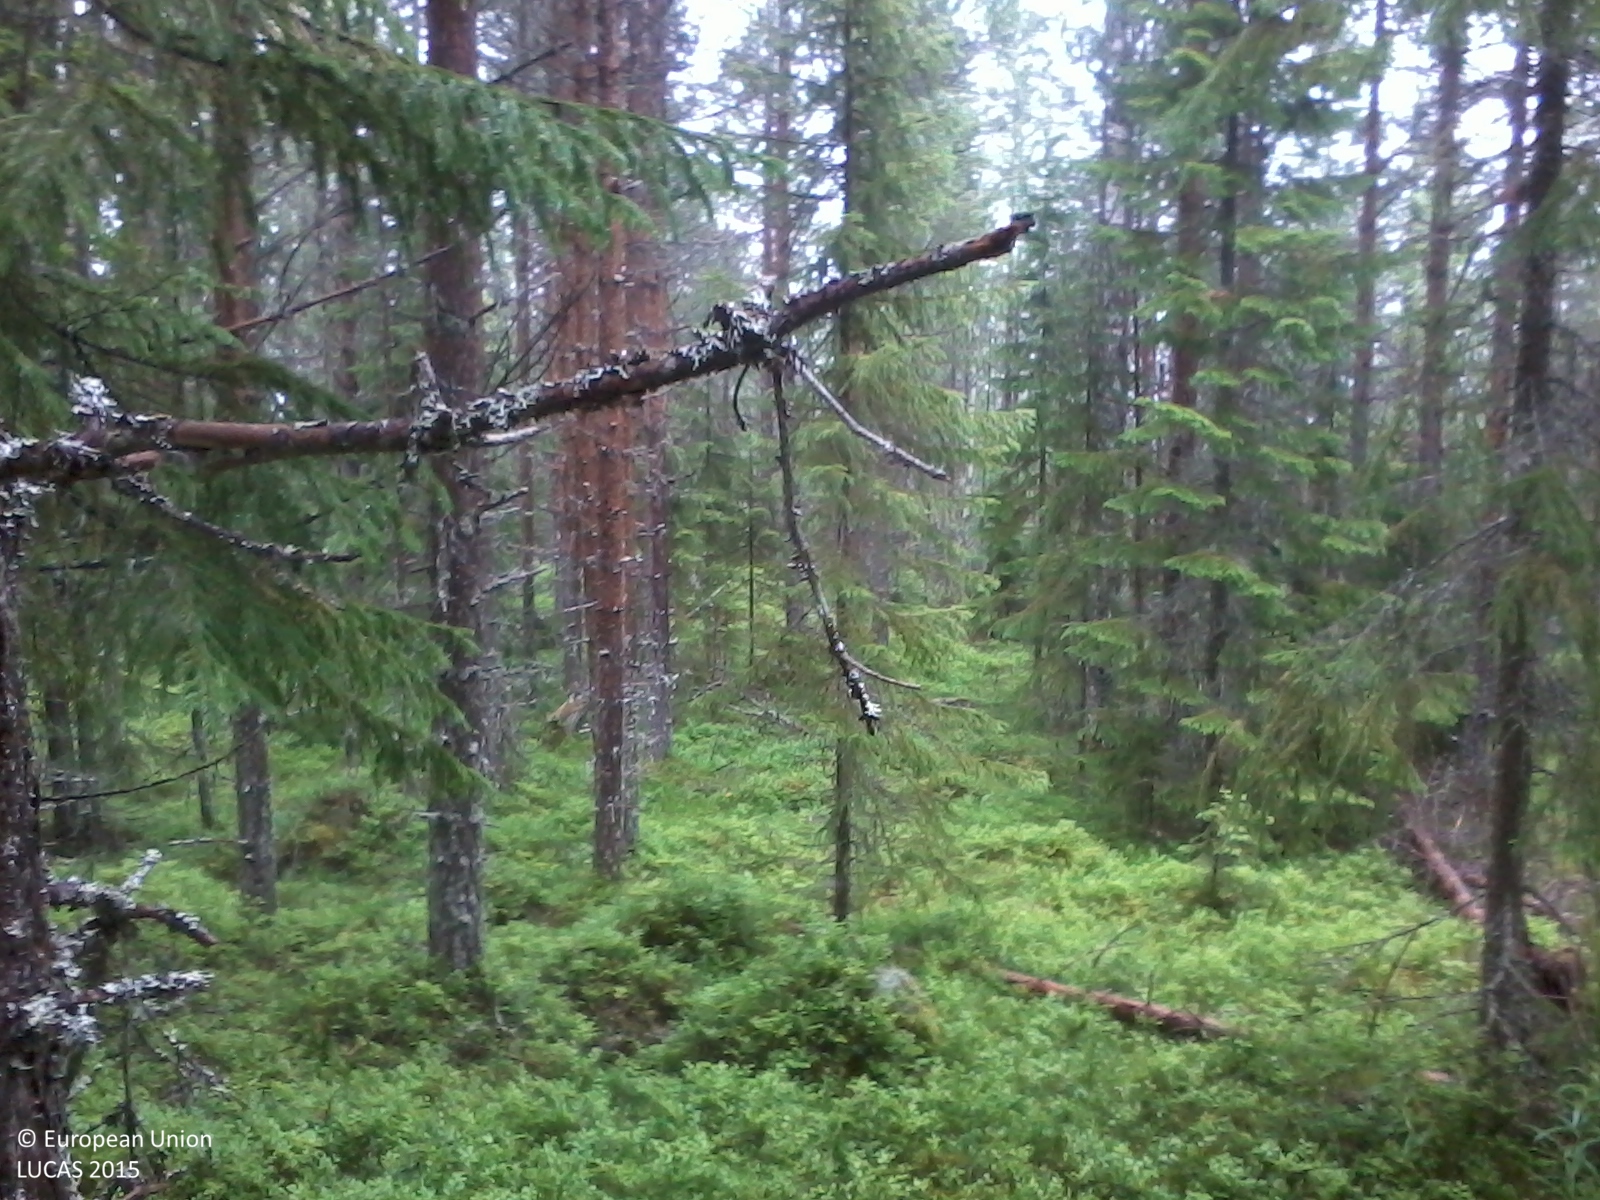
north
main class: Woodland
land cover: Pine dominated coniferous woodland
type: boreal forest
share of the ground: 50 - 75 %
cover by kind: coniferous forest trees 70 %, shrubs 30 %
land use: Forestry
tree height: > 5 m
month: August
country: SE
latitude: 62.8538
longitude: 16.8730
